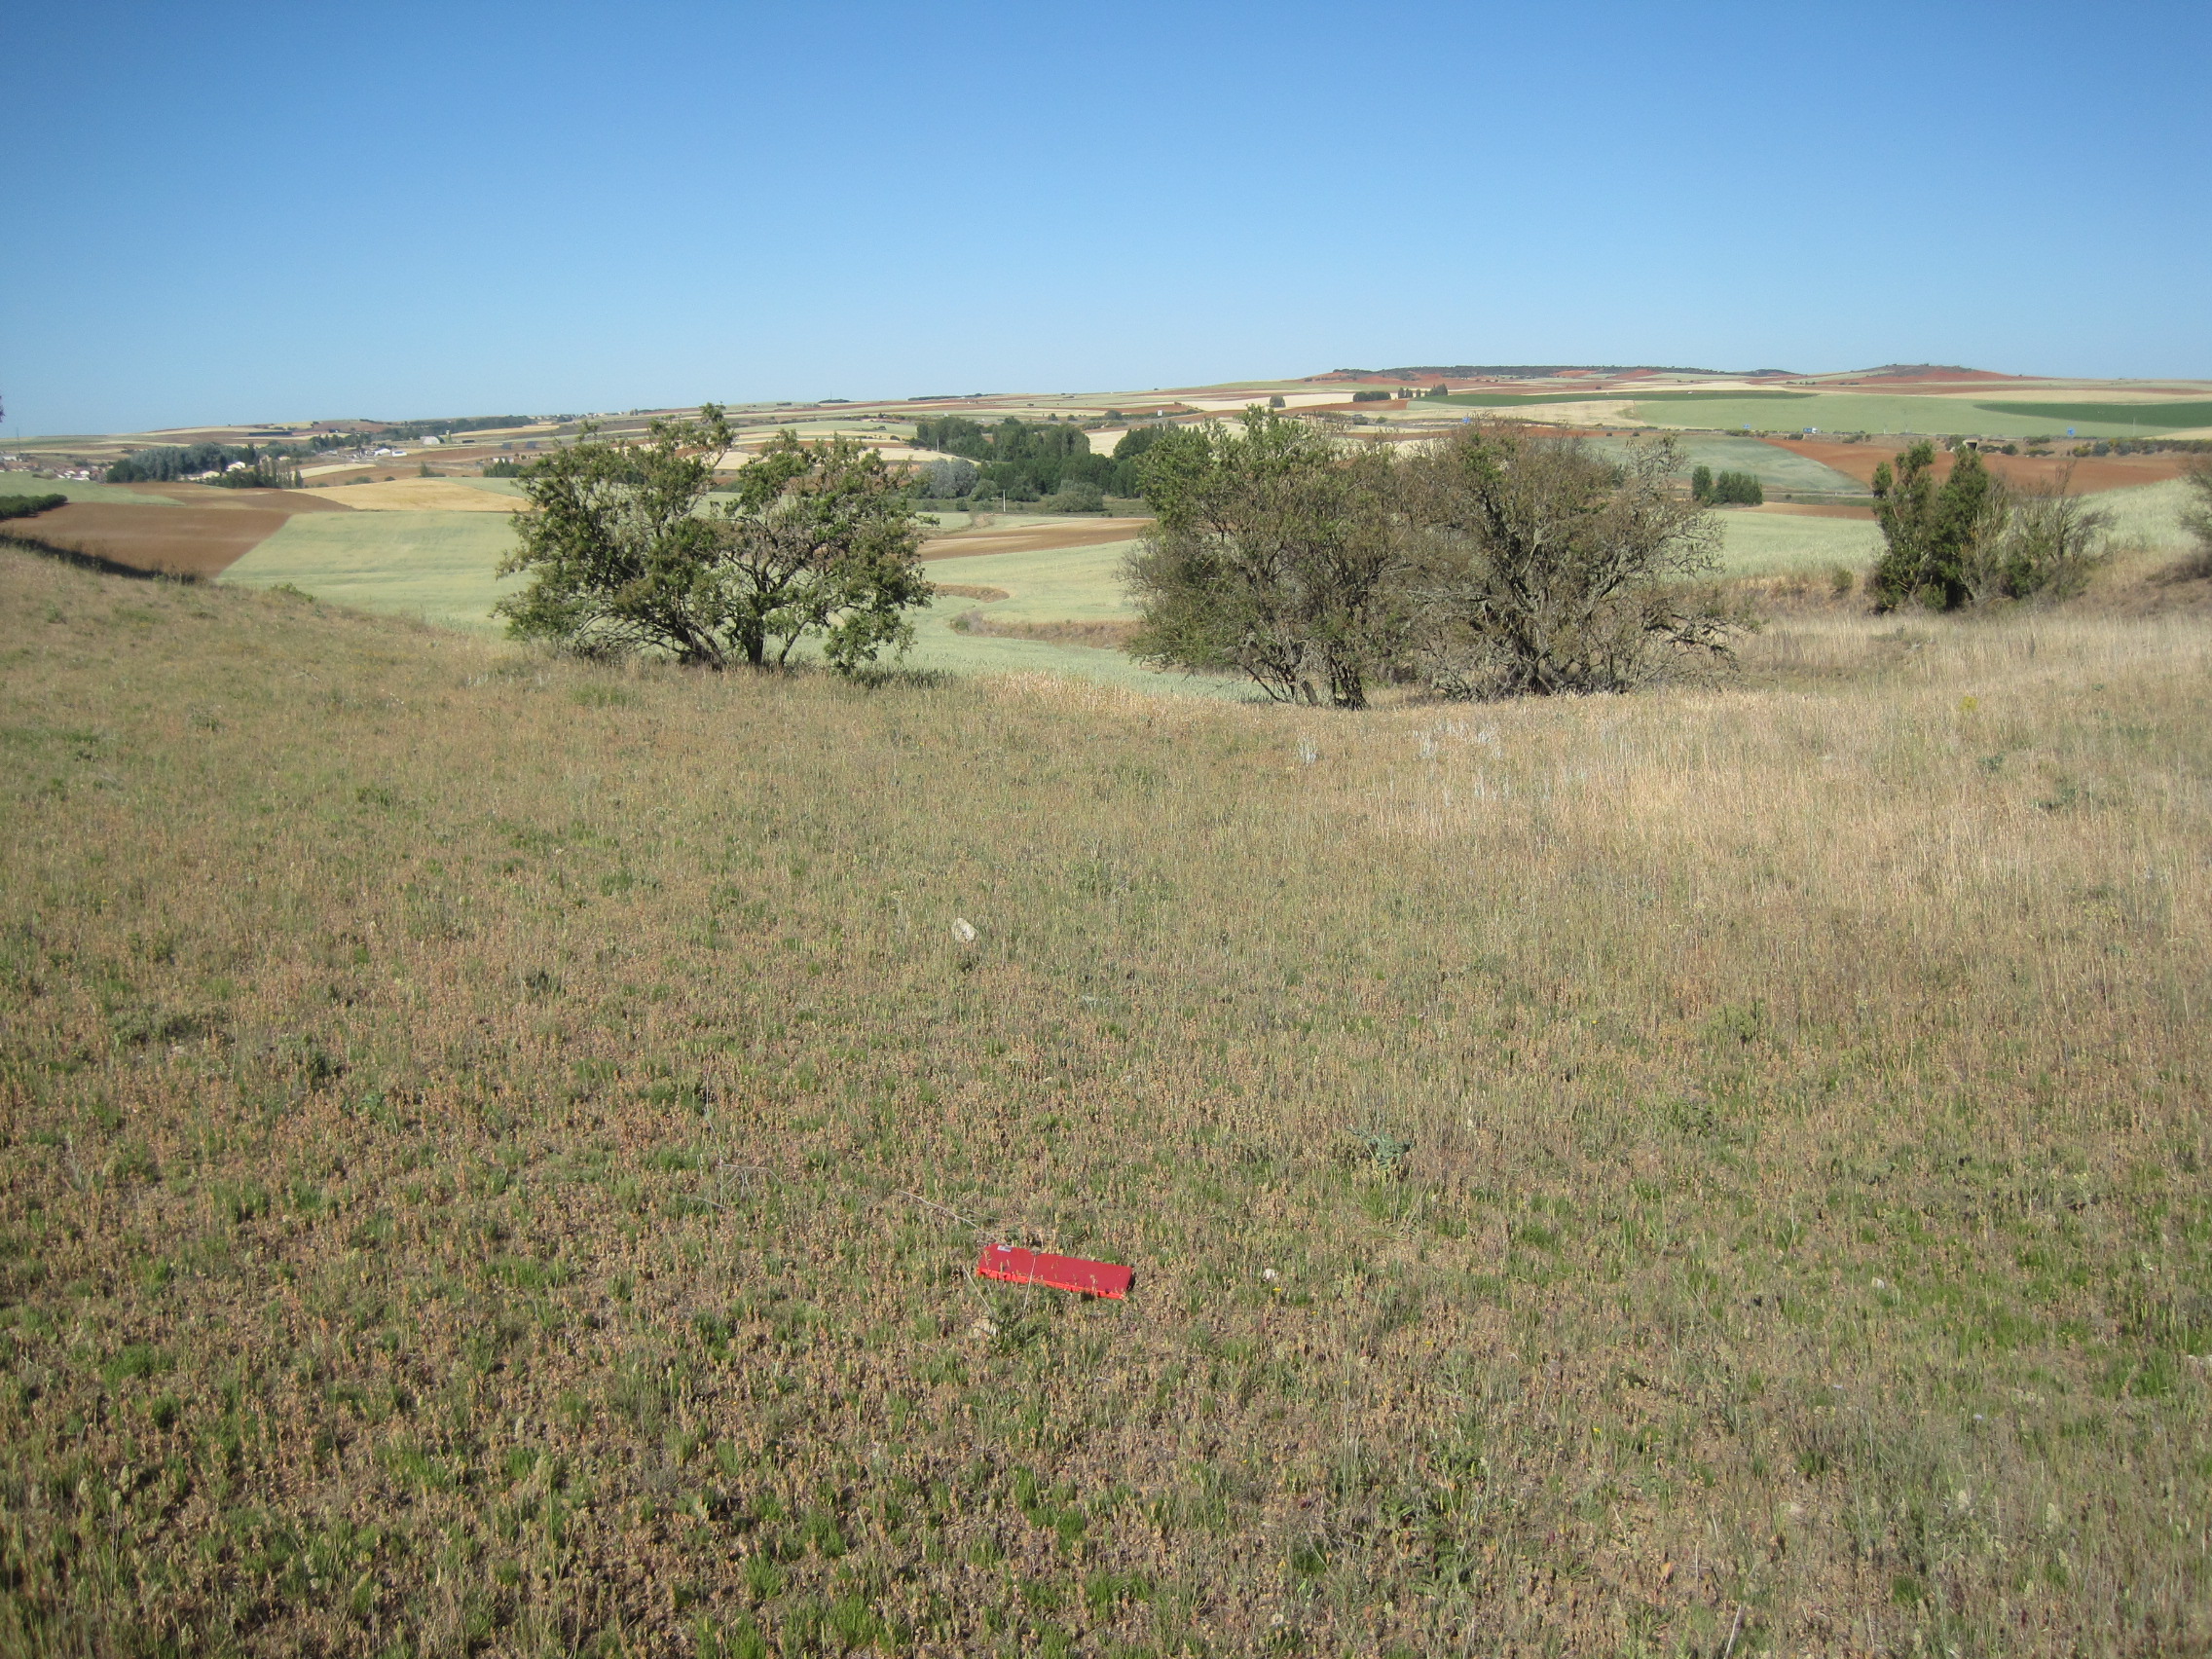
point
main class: Grassland
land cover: Grassland with sparse tree/shrub cover
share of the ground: > 75 %
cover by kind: herbaceous plants 95 %, broadleaved forest trees 5 %
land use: Semi-natural and natural areas not in use
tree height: < 5 m
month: May
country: ES
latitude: 41.1829
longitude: -5.3456
